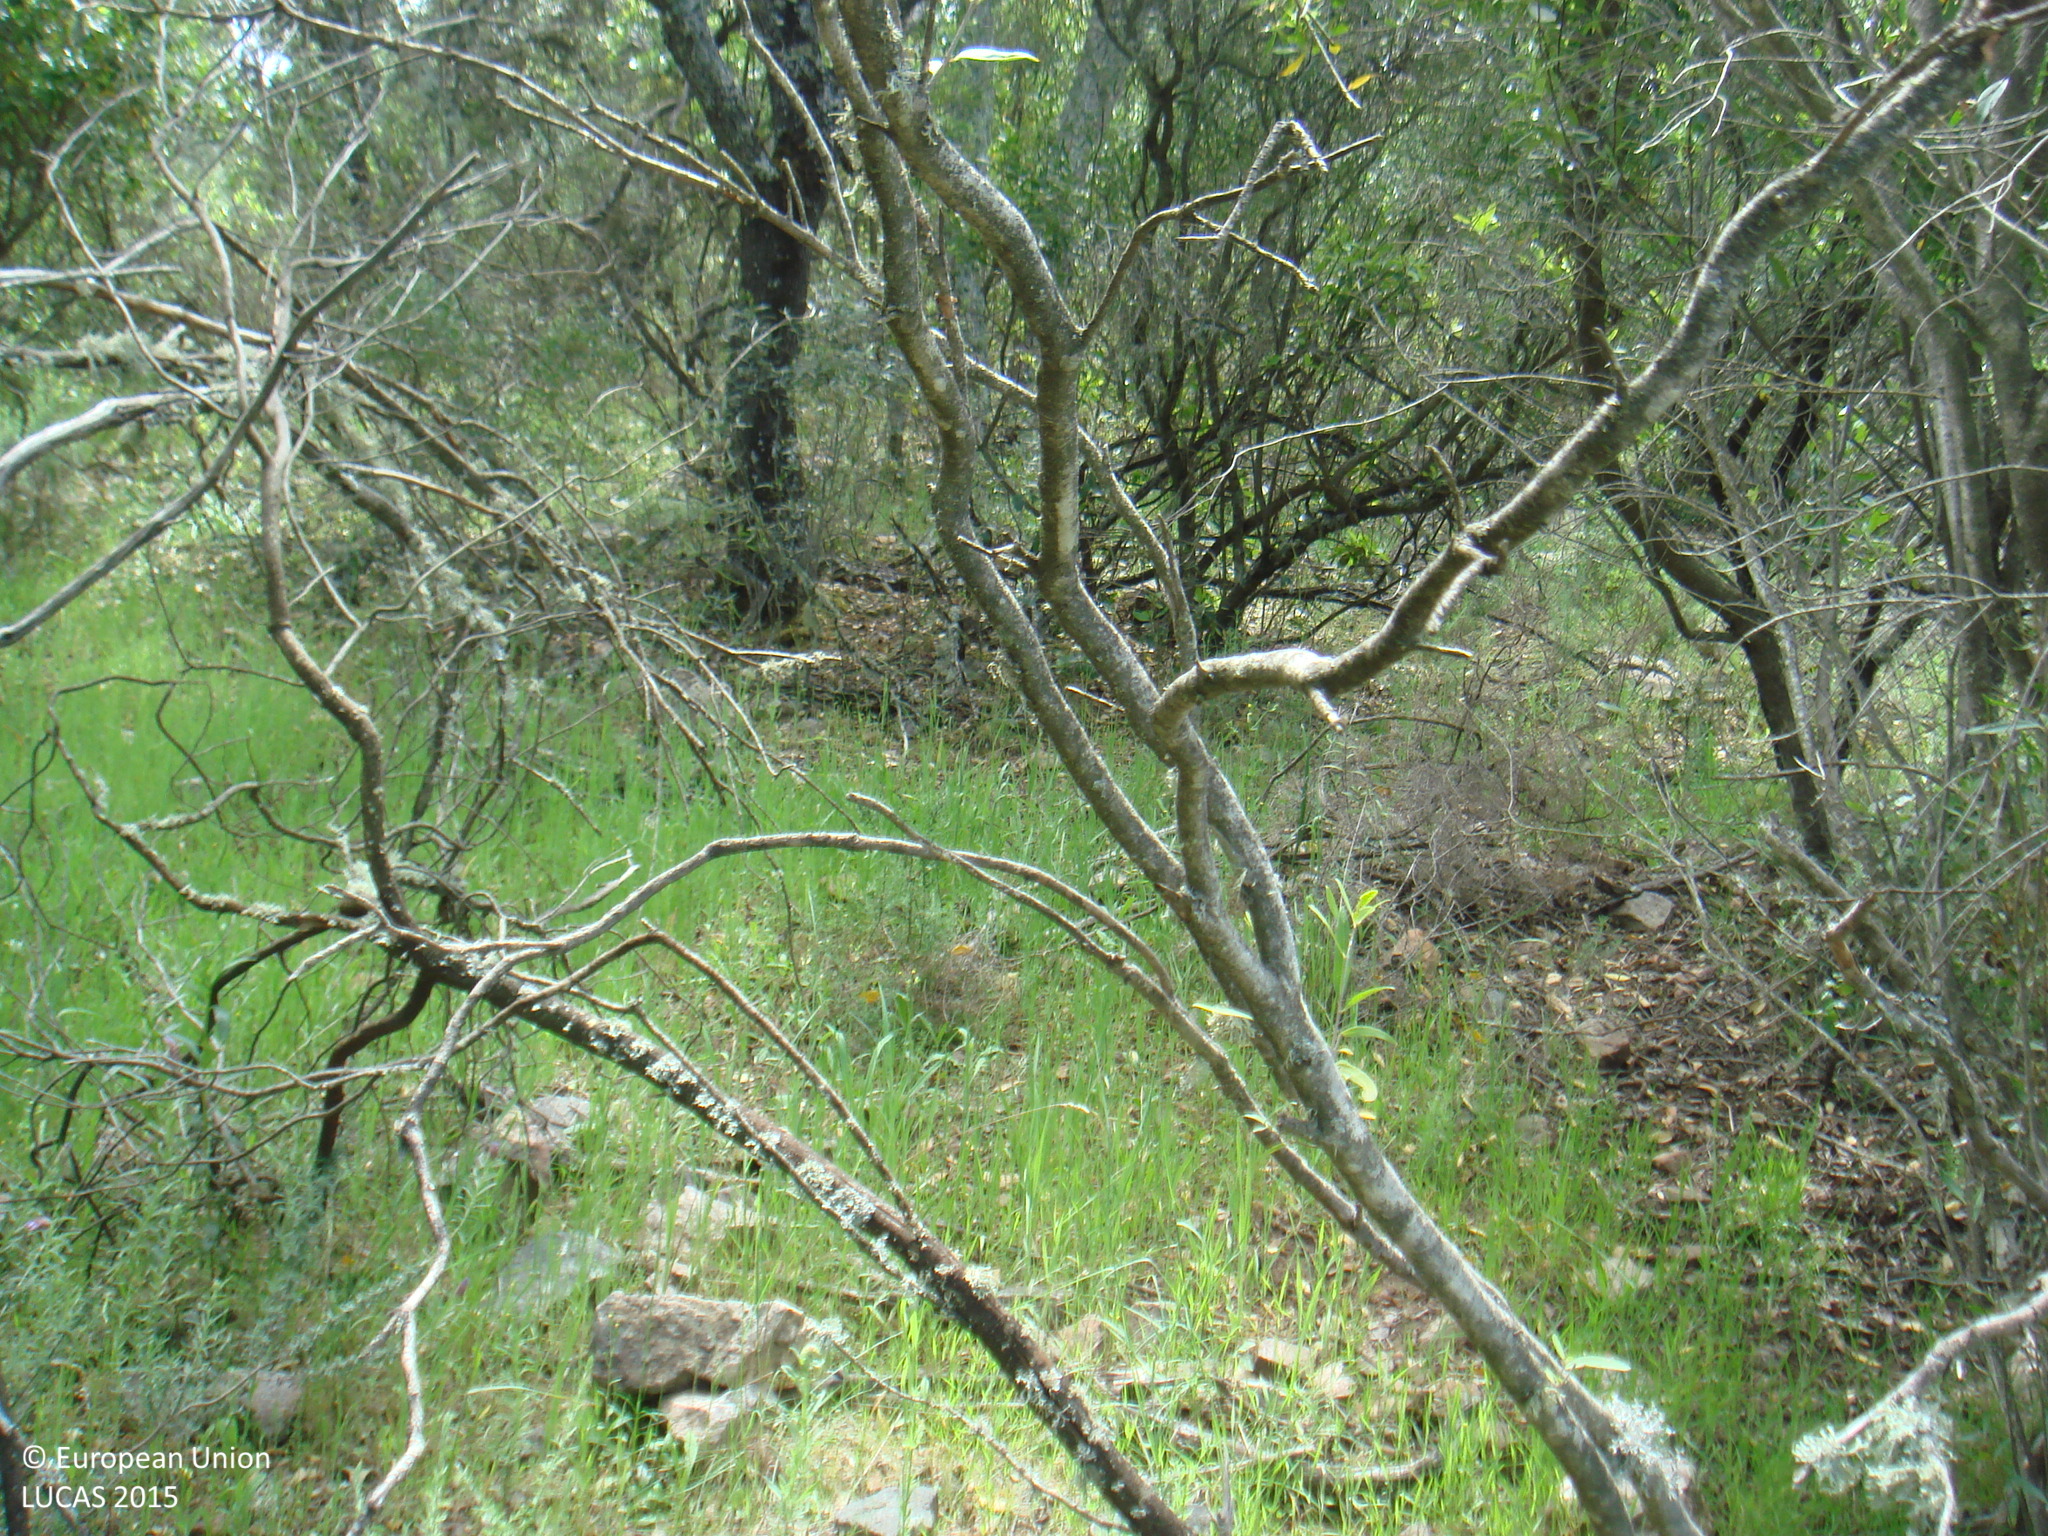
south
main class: Woodland
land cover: Broadleaved woodland
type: broadleaved evergreen forest
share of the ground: 25 - 50 %
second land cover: Shrubland without tree cover
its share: 50 - 75 %
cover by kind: shrubs 50 %, broadleaved forest trees 40 %, herbaceous plants 10 %
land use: Forestry
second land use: Agriculture (excluding fallow land and kitchen gardens)
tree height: > 5 m
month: May
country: ES
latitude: 38.3207
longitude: -5.0899
